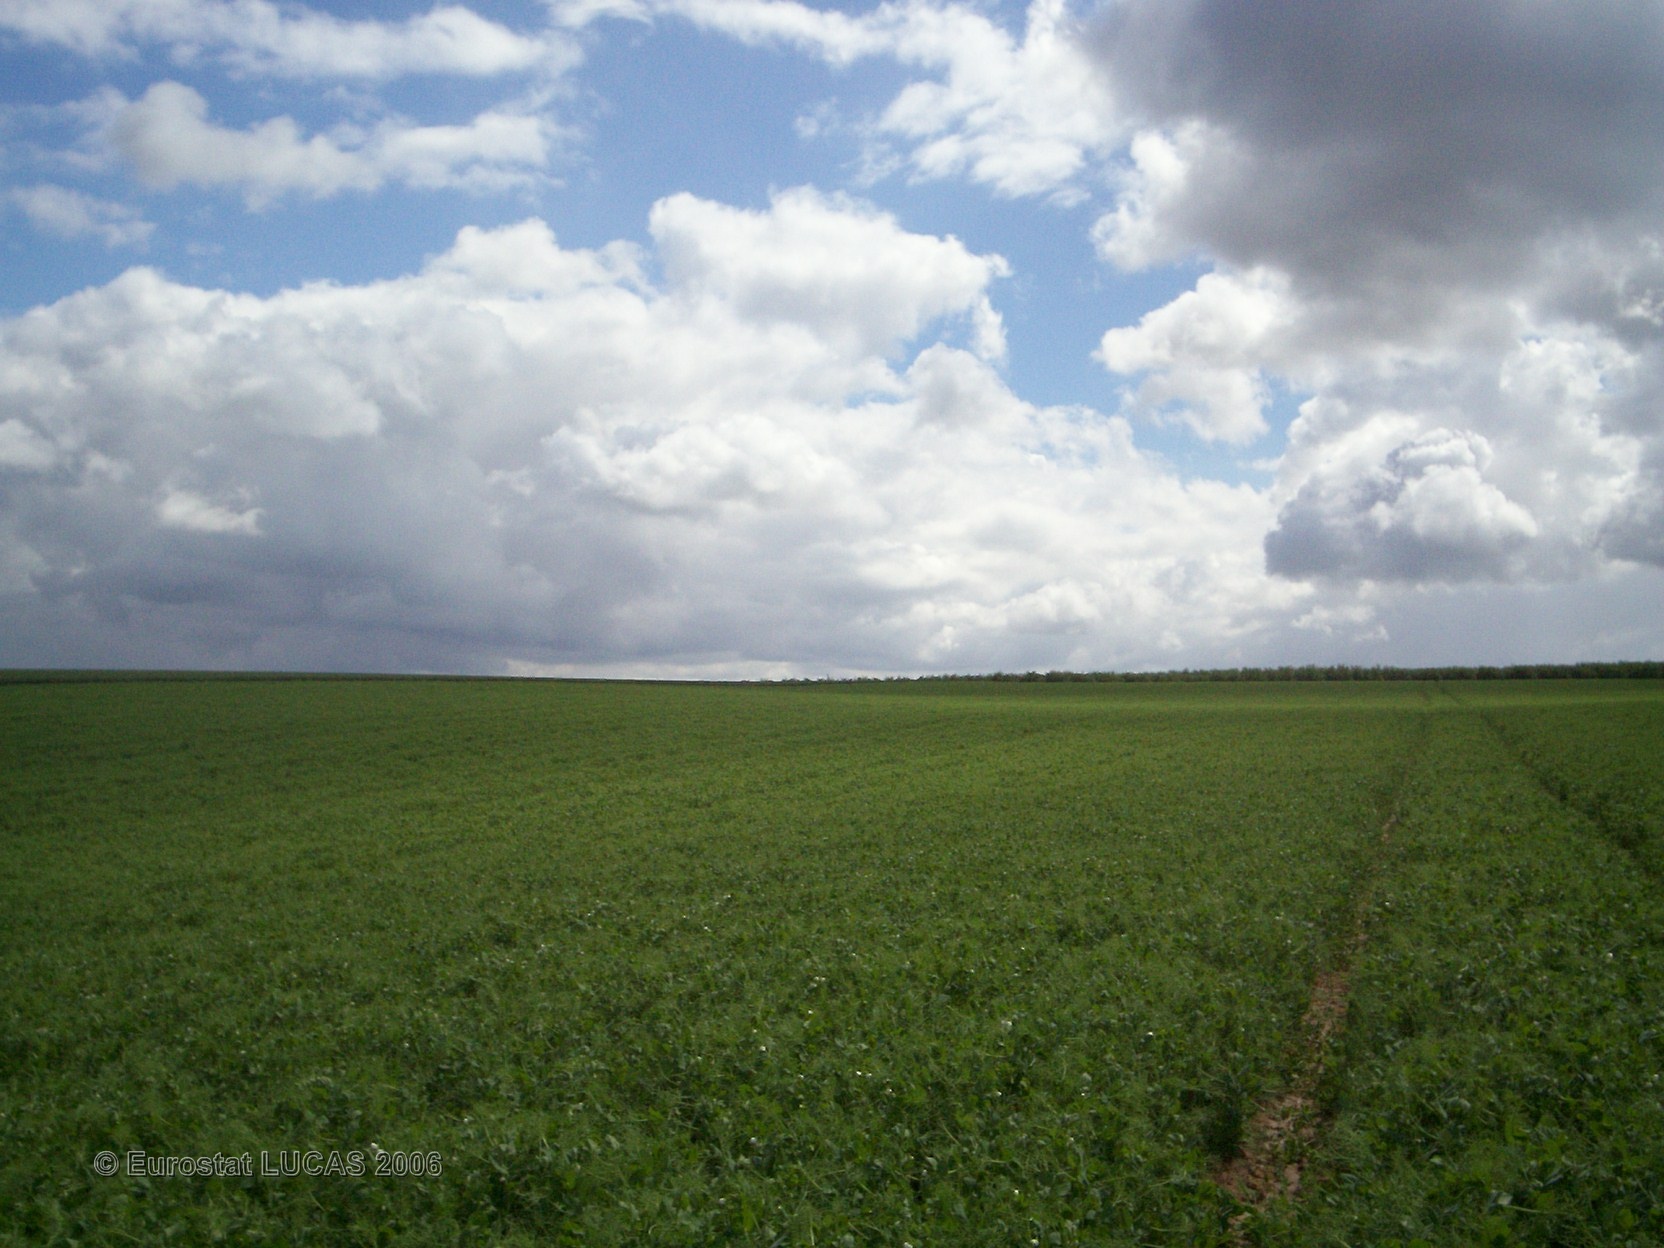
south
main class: Cropland
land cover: Dry pulses
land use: Agriculture (excluding fallow land and kitchen gardens)
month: May
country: FR
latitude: 49.1972
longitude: 2.7851
